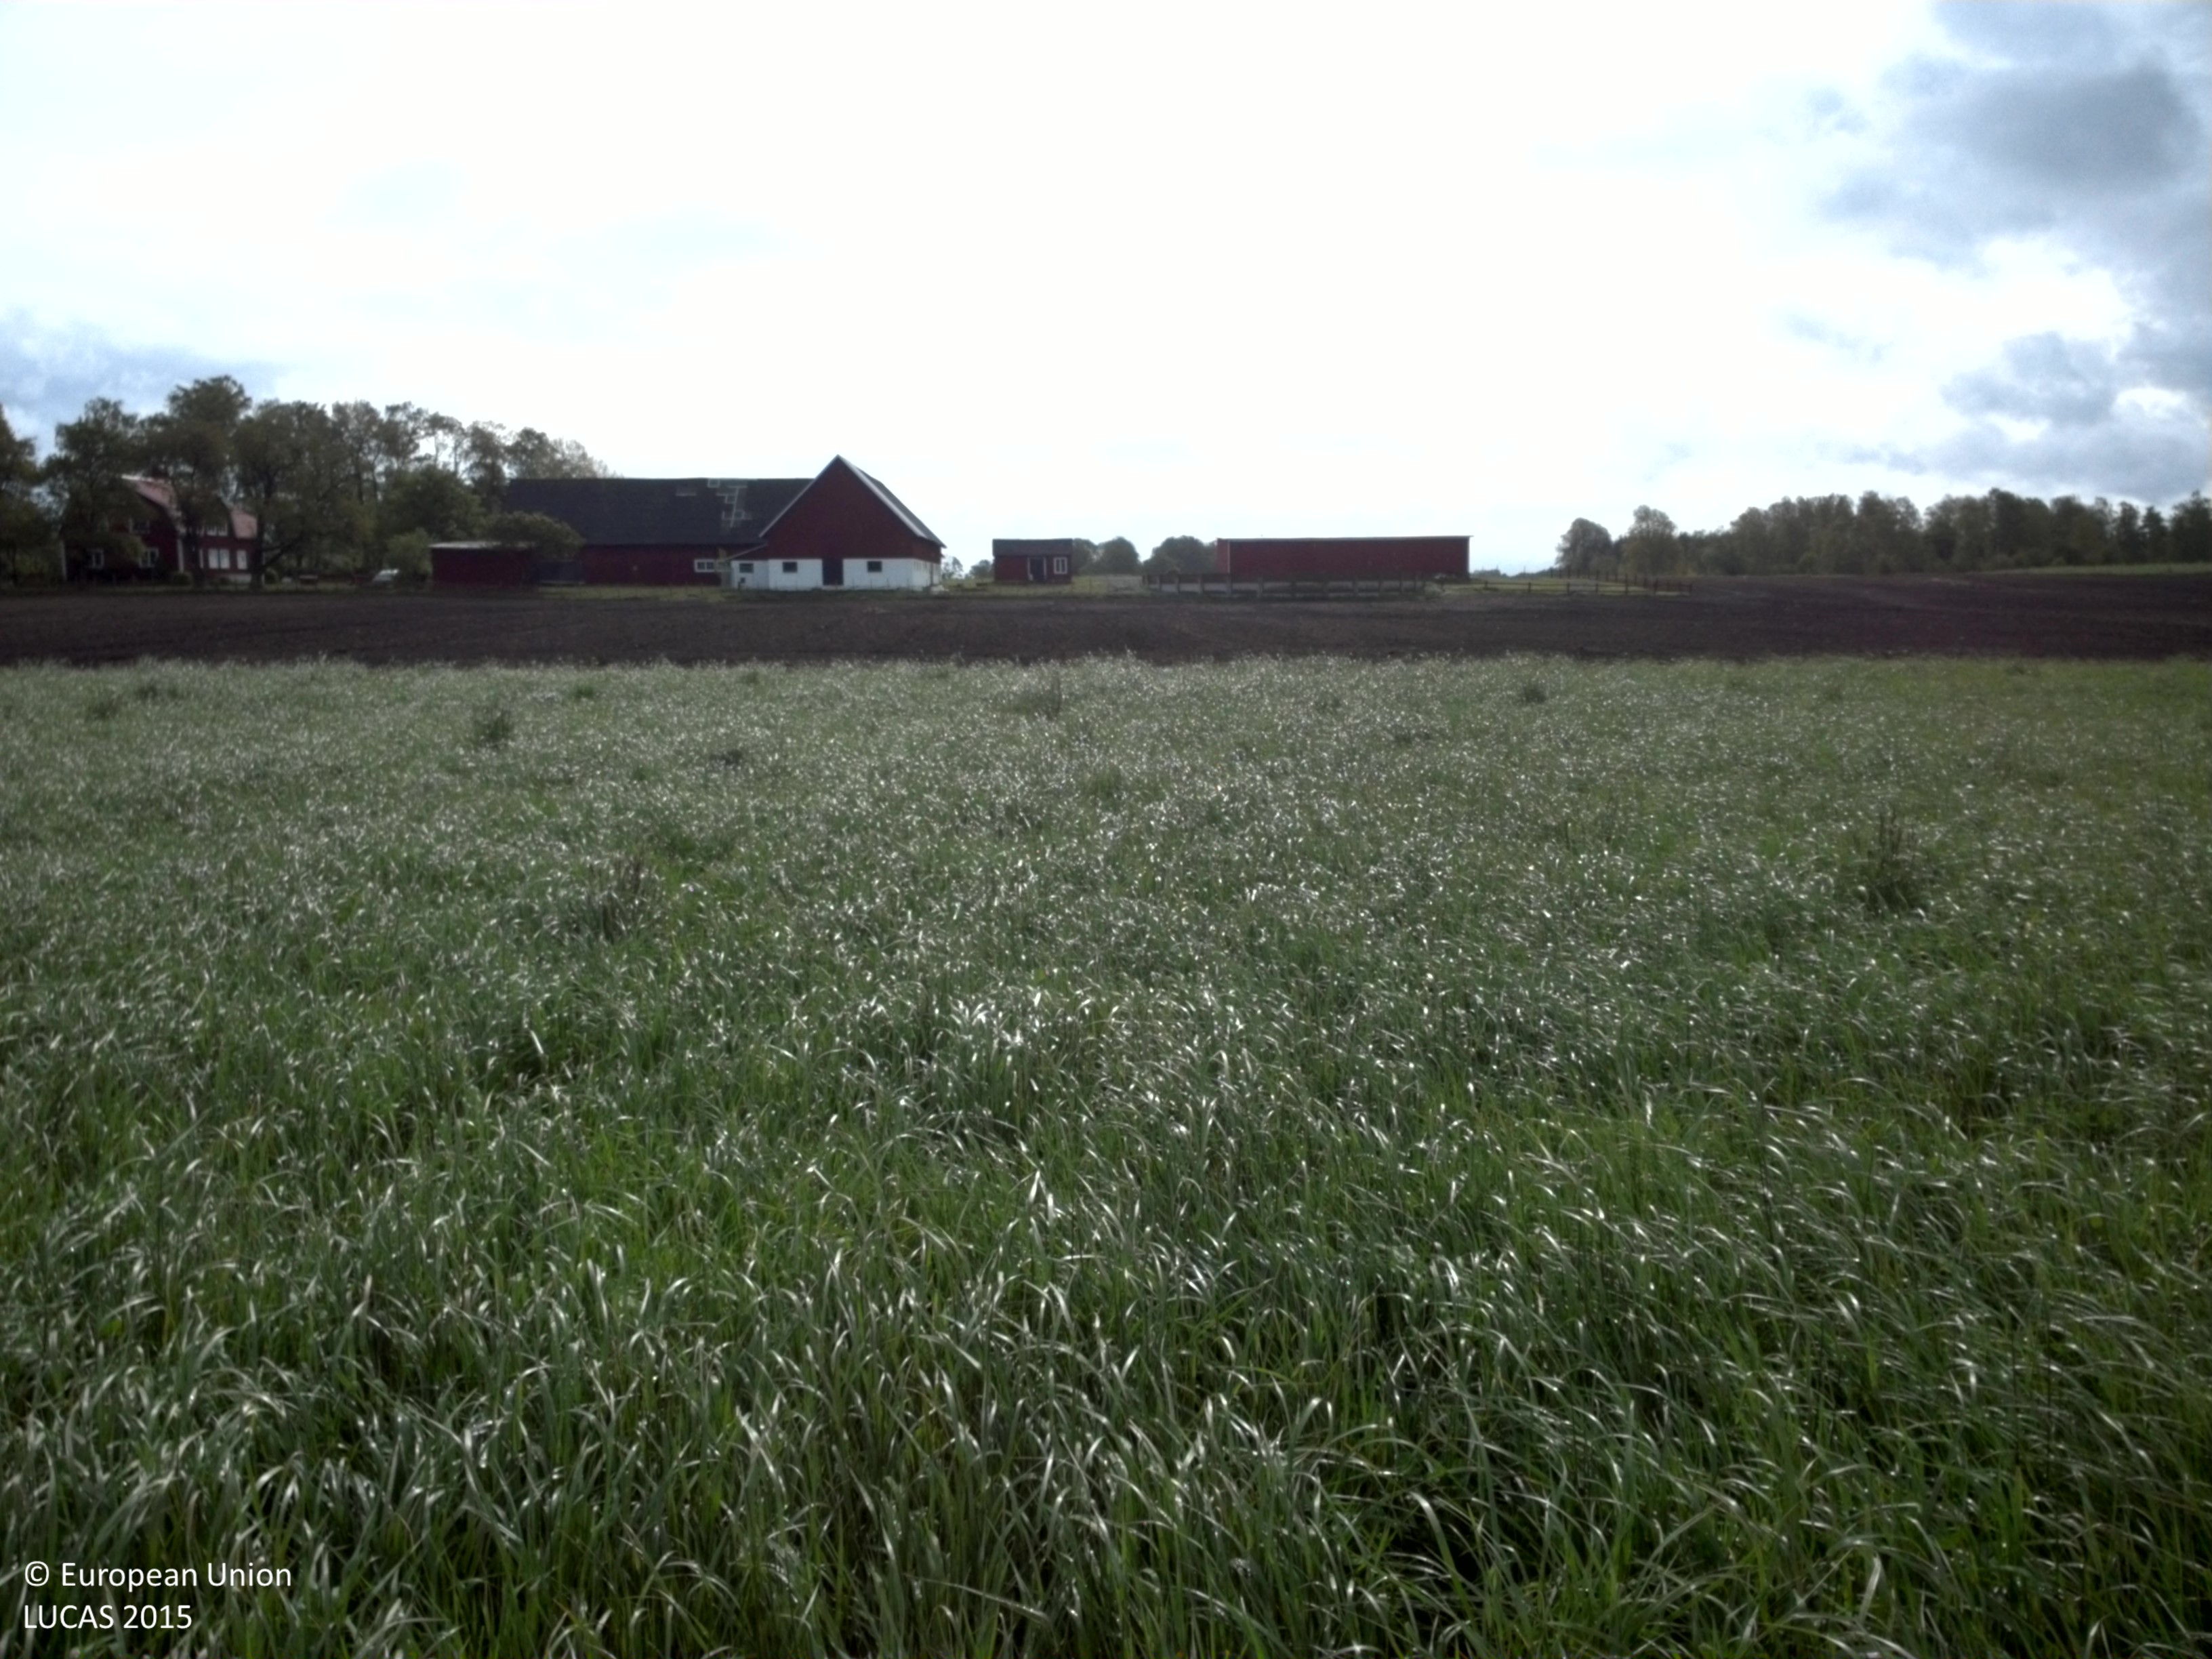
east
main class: Cropland
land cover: Temporary grasslands
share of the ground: > 75 %
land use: Agriculture (excluding fallow land and kitchen gardens)
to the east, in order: Temporary grasslands; Ditches and canals; Oats; Grass margins; Artificial constructions in urban areas; Grassland without tree/shrub cover
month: June
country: SE
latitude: 56.7372
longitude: 14.5581
